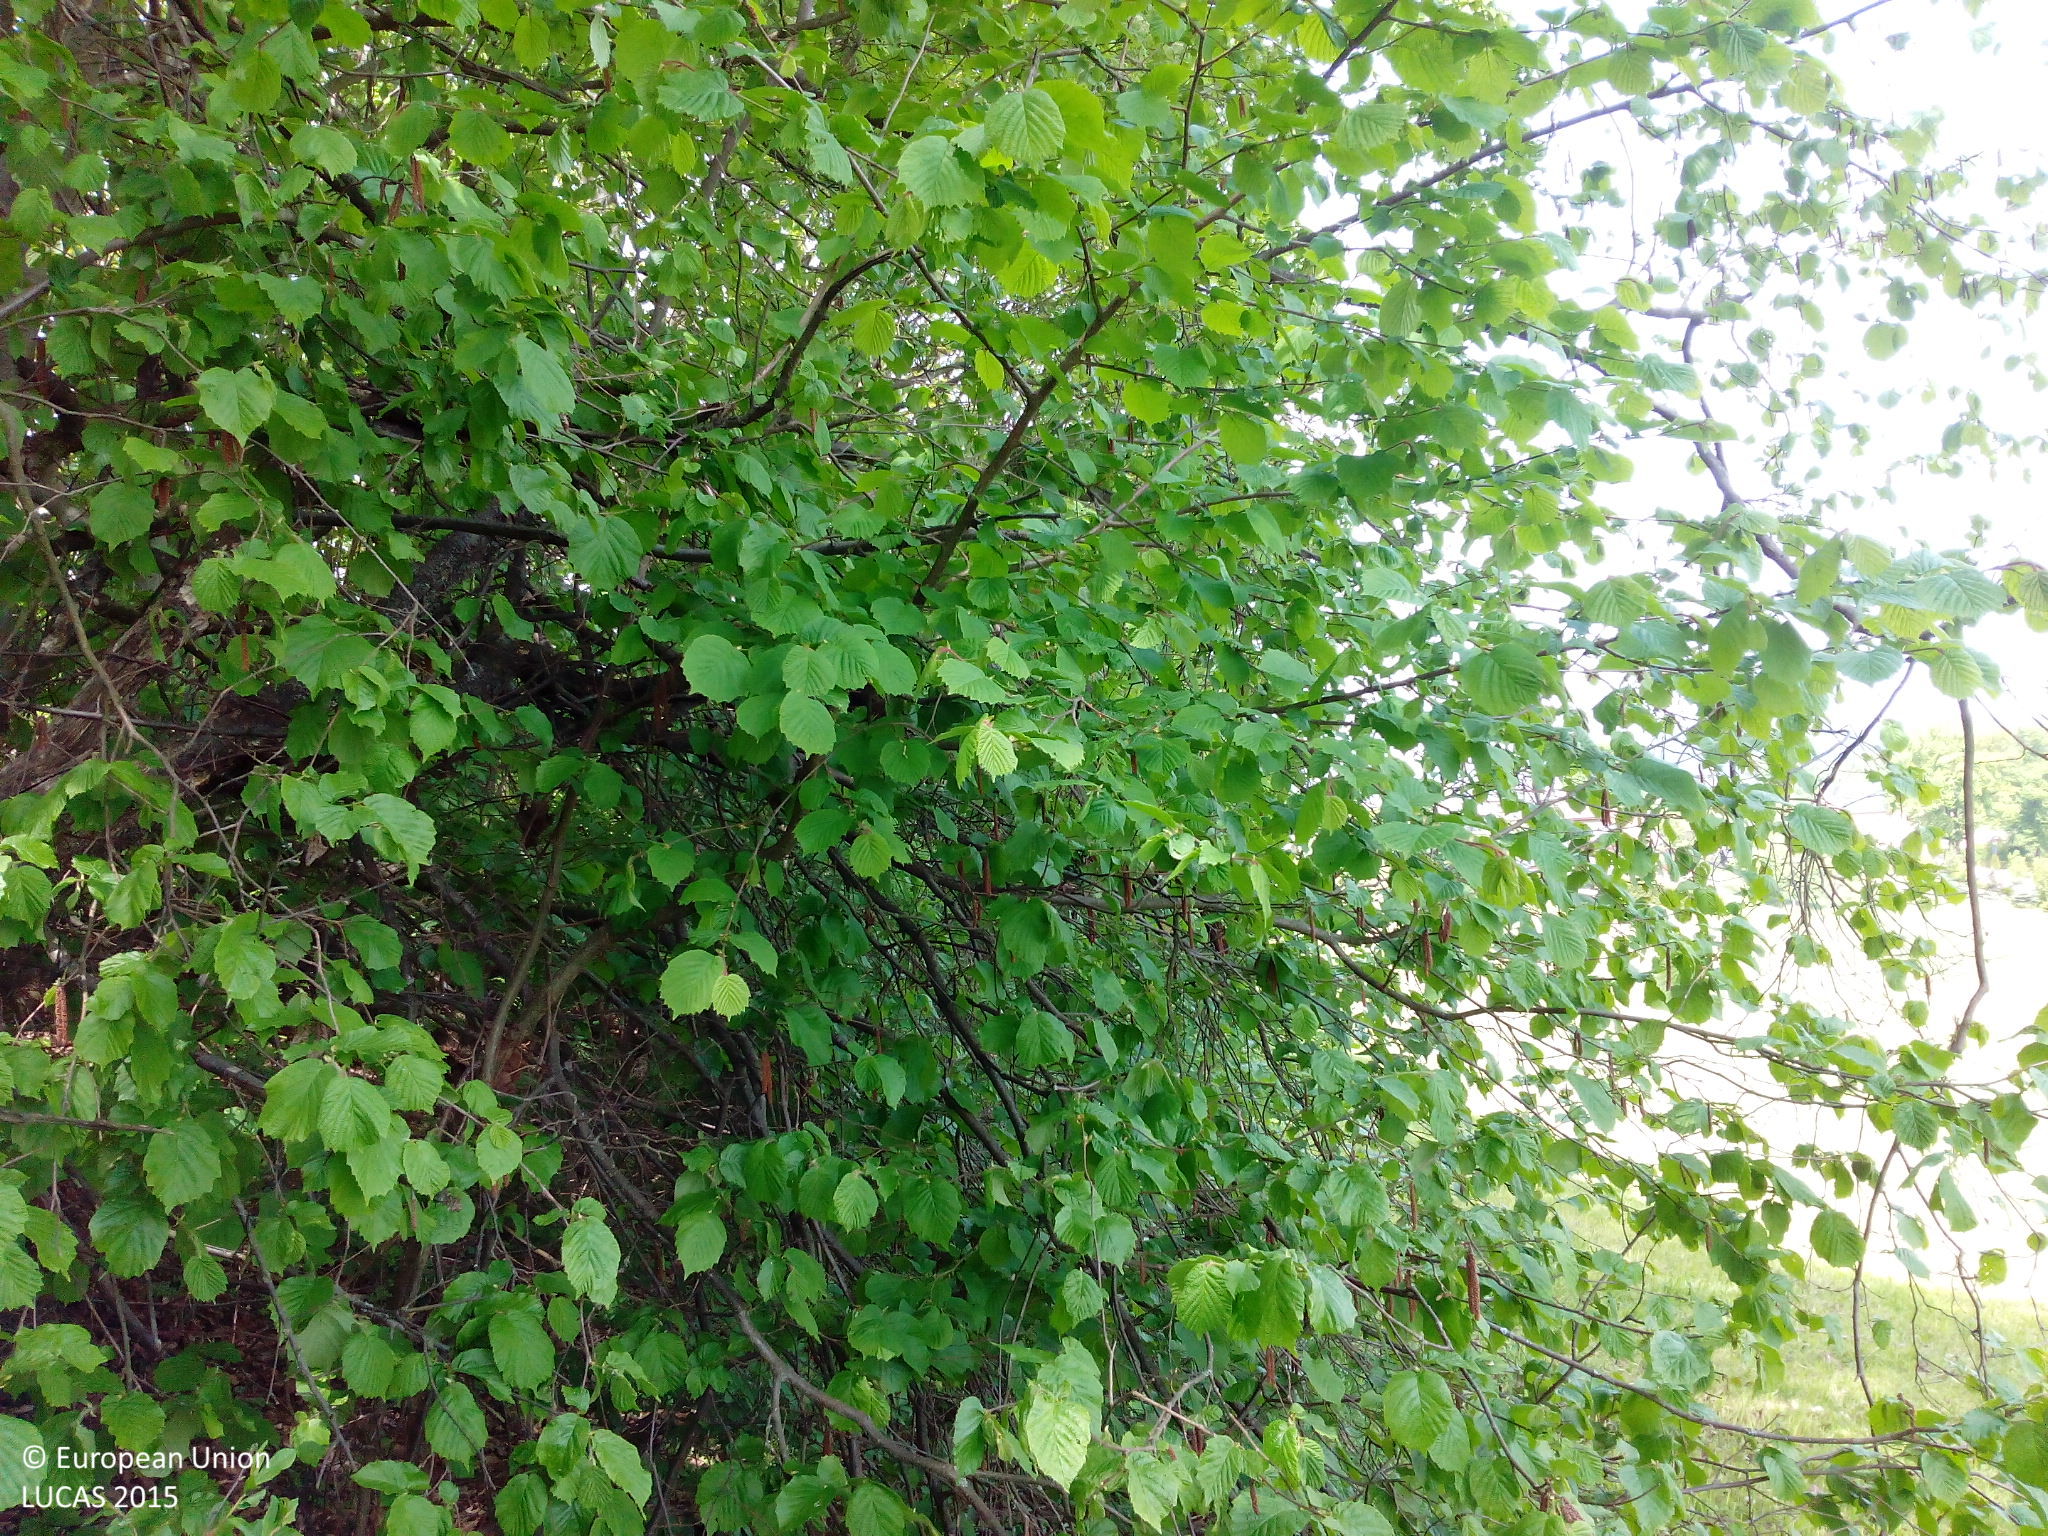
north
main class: Woodland
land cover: Broadleaved woodland
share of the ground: > 75 %
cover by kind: broadleaved forest trees 100 %
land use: Agriculture (excluding fallow land and kitchen gardens)
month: May
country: DE
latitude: 50.7725
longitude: 13.0772
